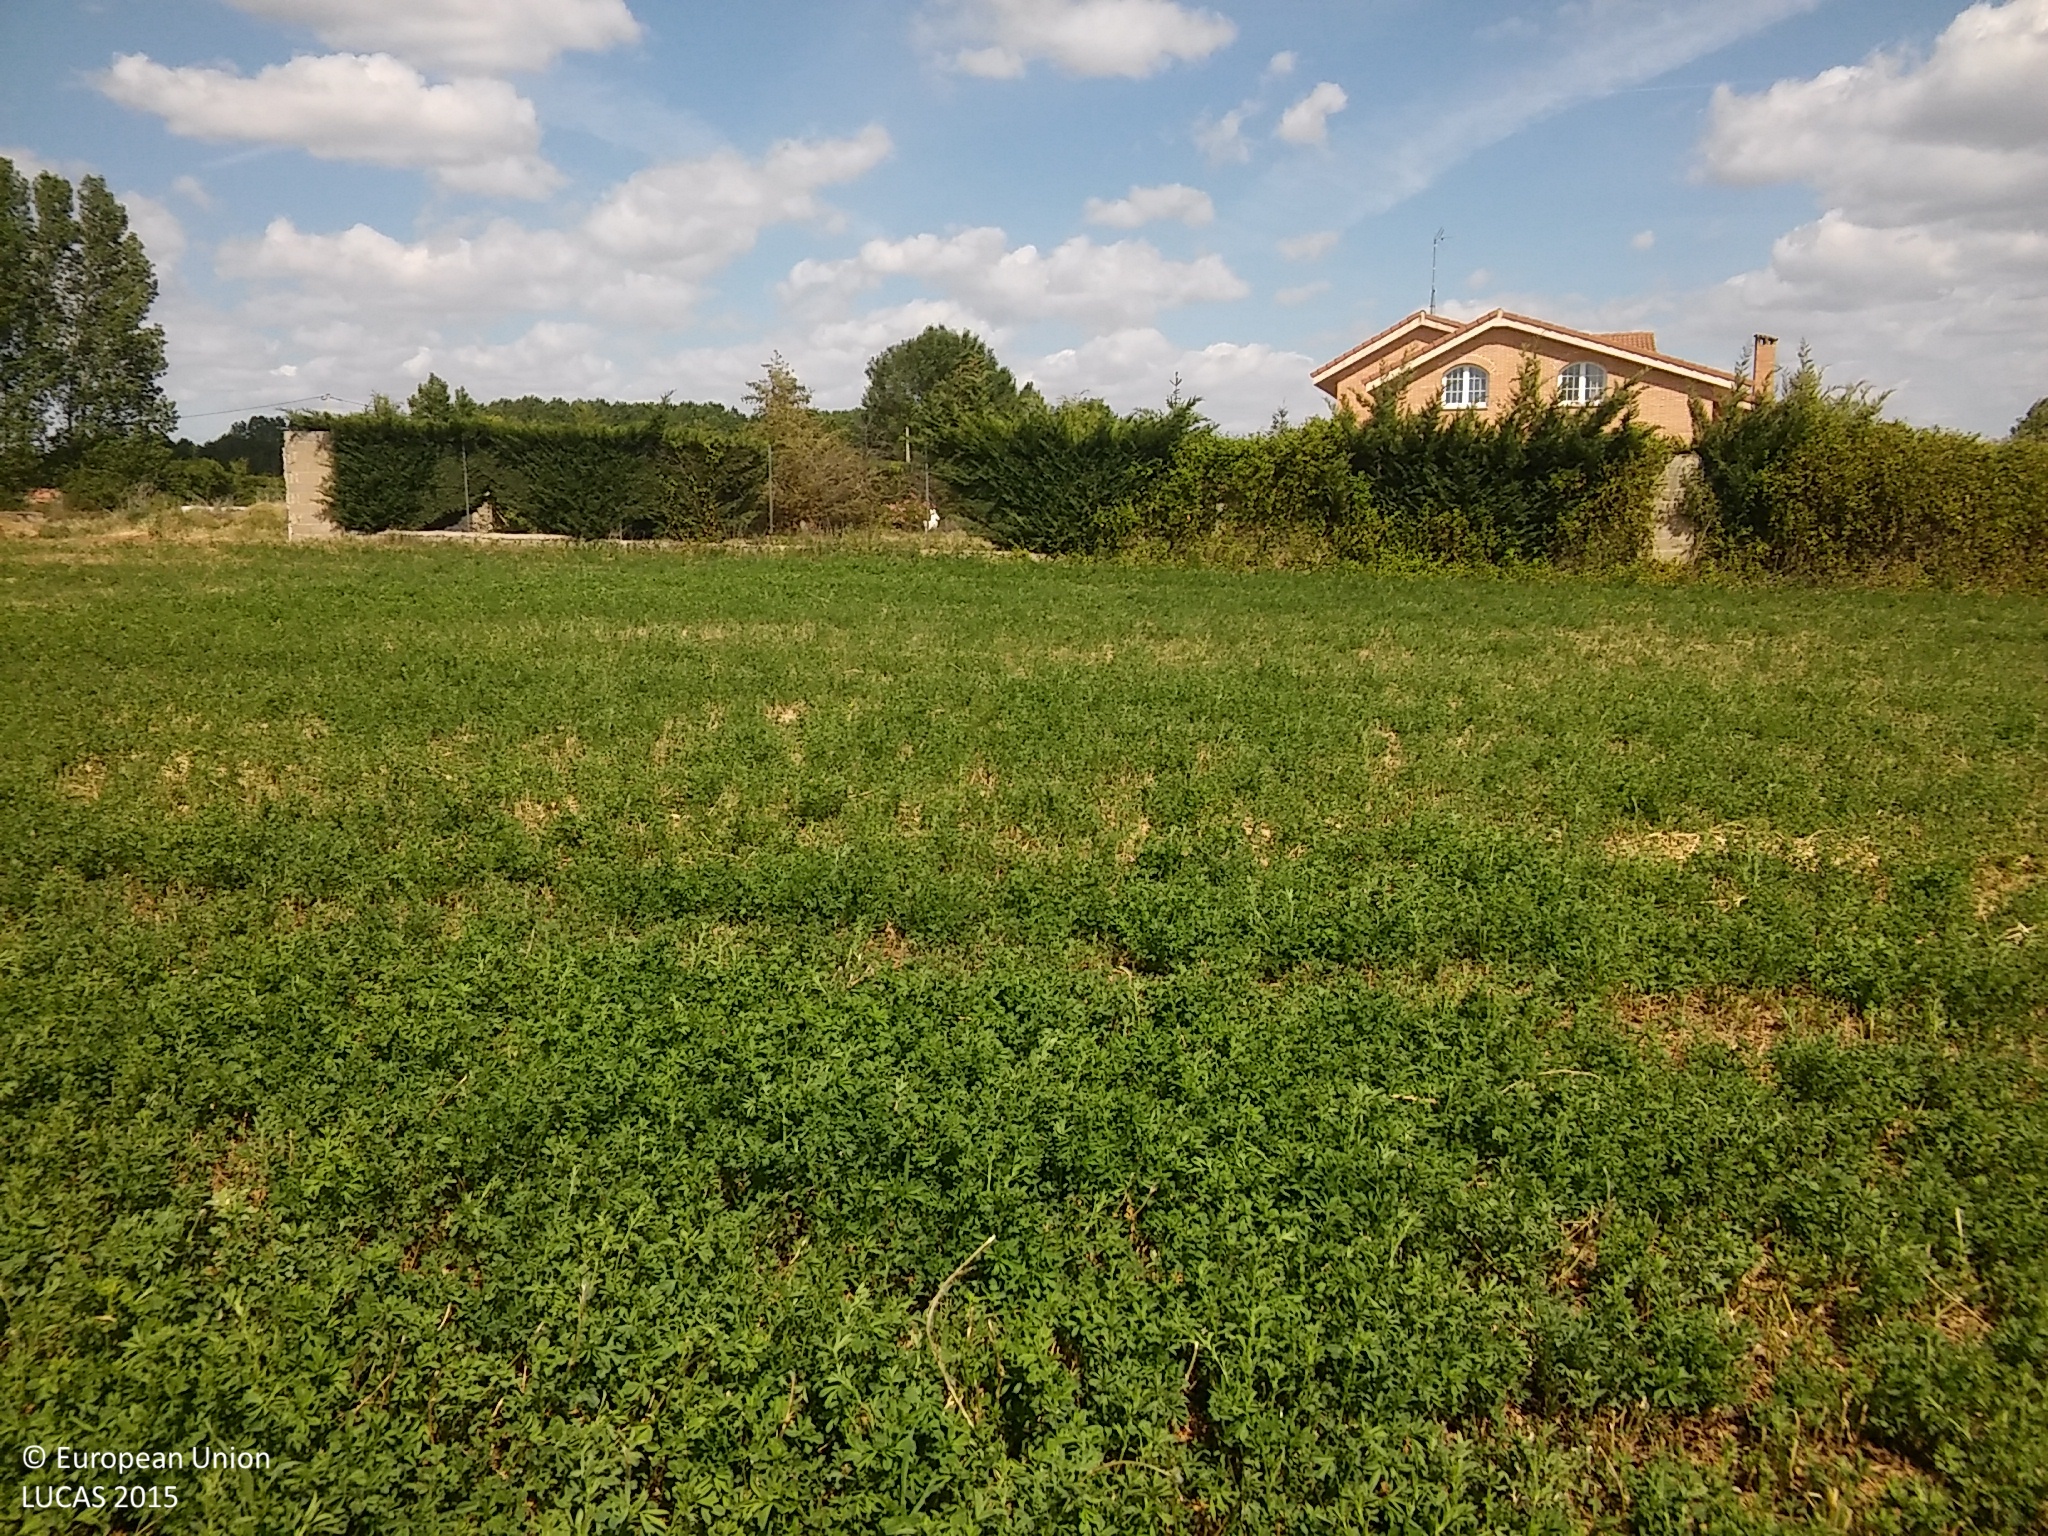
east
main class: Cropland
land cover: Lucerne
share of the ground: 25 - 50 %
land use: Agriculture (excluding fallow land and kitchen gardens)
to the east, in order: Lucerne; Ditches and canals; Grass margins; Artificial constructions in urban areas; Grassland without tree/shrub cover; Ditches and canals; Grass margins; Abandoned hedges; Other bare soil; Grass margins; Tracks; Spontaneously vegetated surfaces; Groves; Grassland without tree/shrub cover
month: May
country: ES
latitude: 41.6510
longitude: -3.6565
